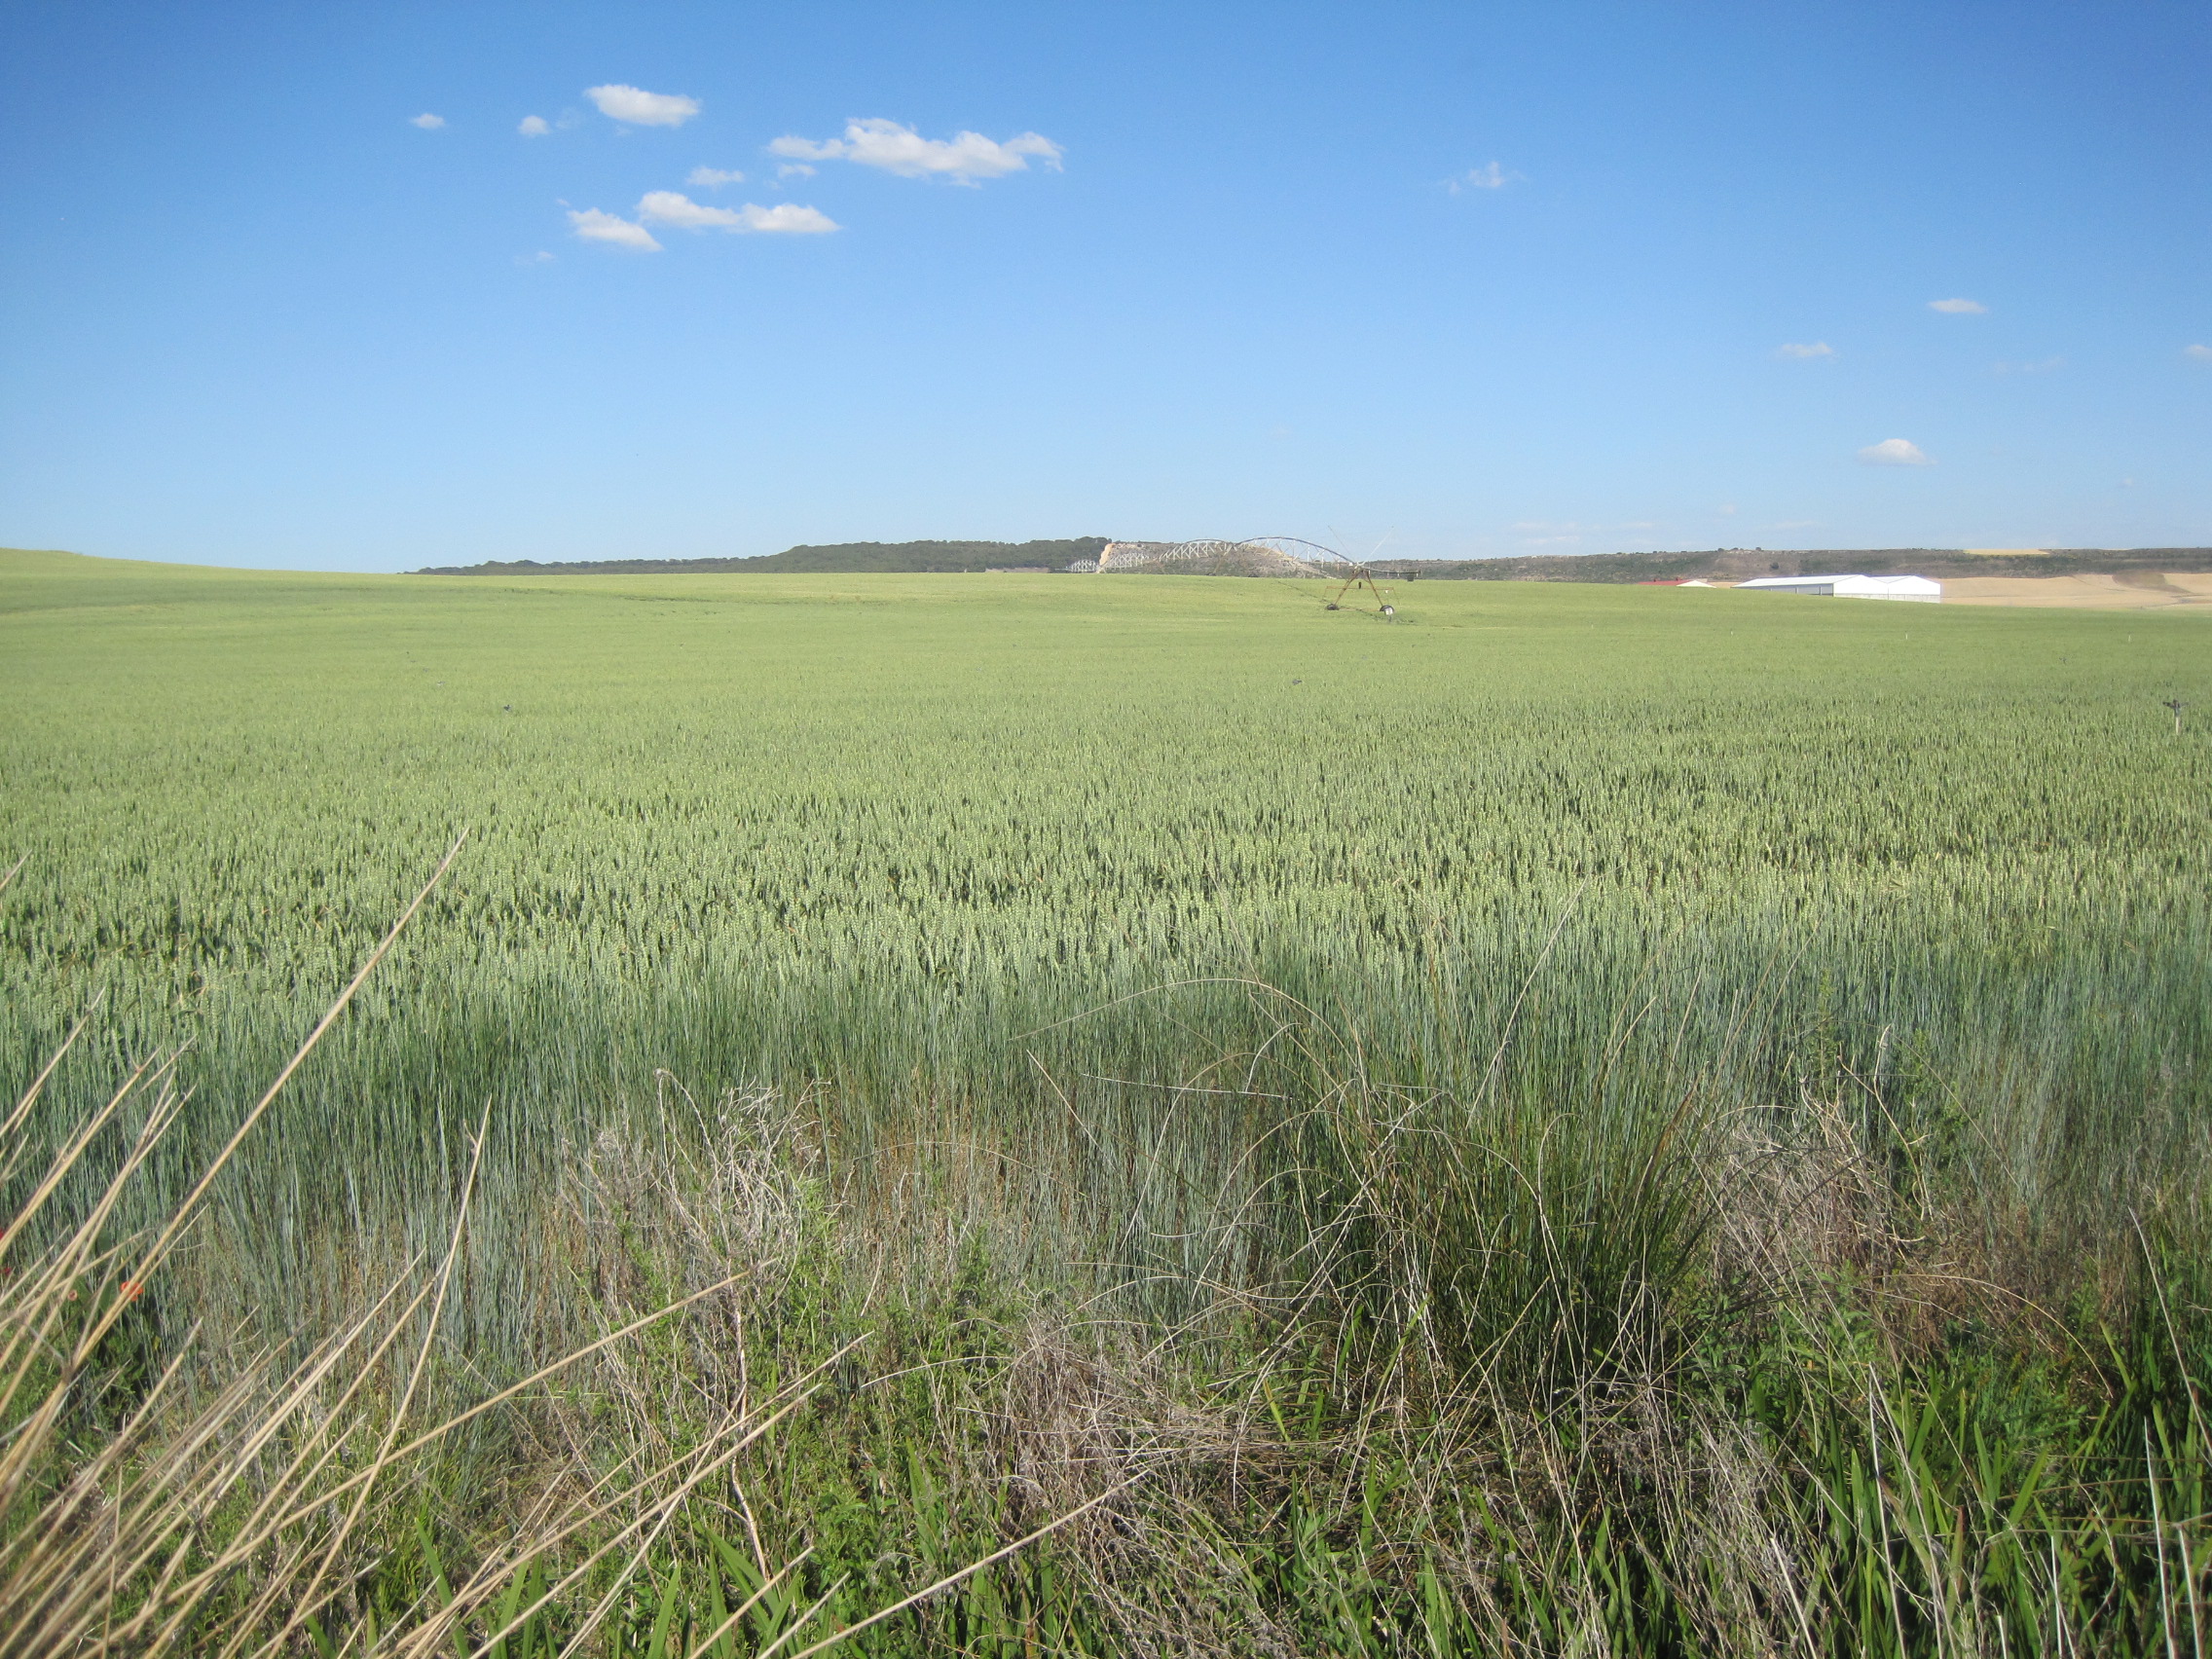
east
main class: Cropland
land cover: Common wheat
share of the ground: > 75 %
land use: Agriculture (excluding fallow land and kitchen gardens)
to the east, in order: Grass margins; Rivers and streams; Common wheat
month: June
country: ES
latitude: 41.7528
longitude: -5.2206
